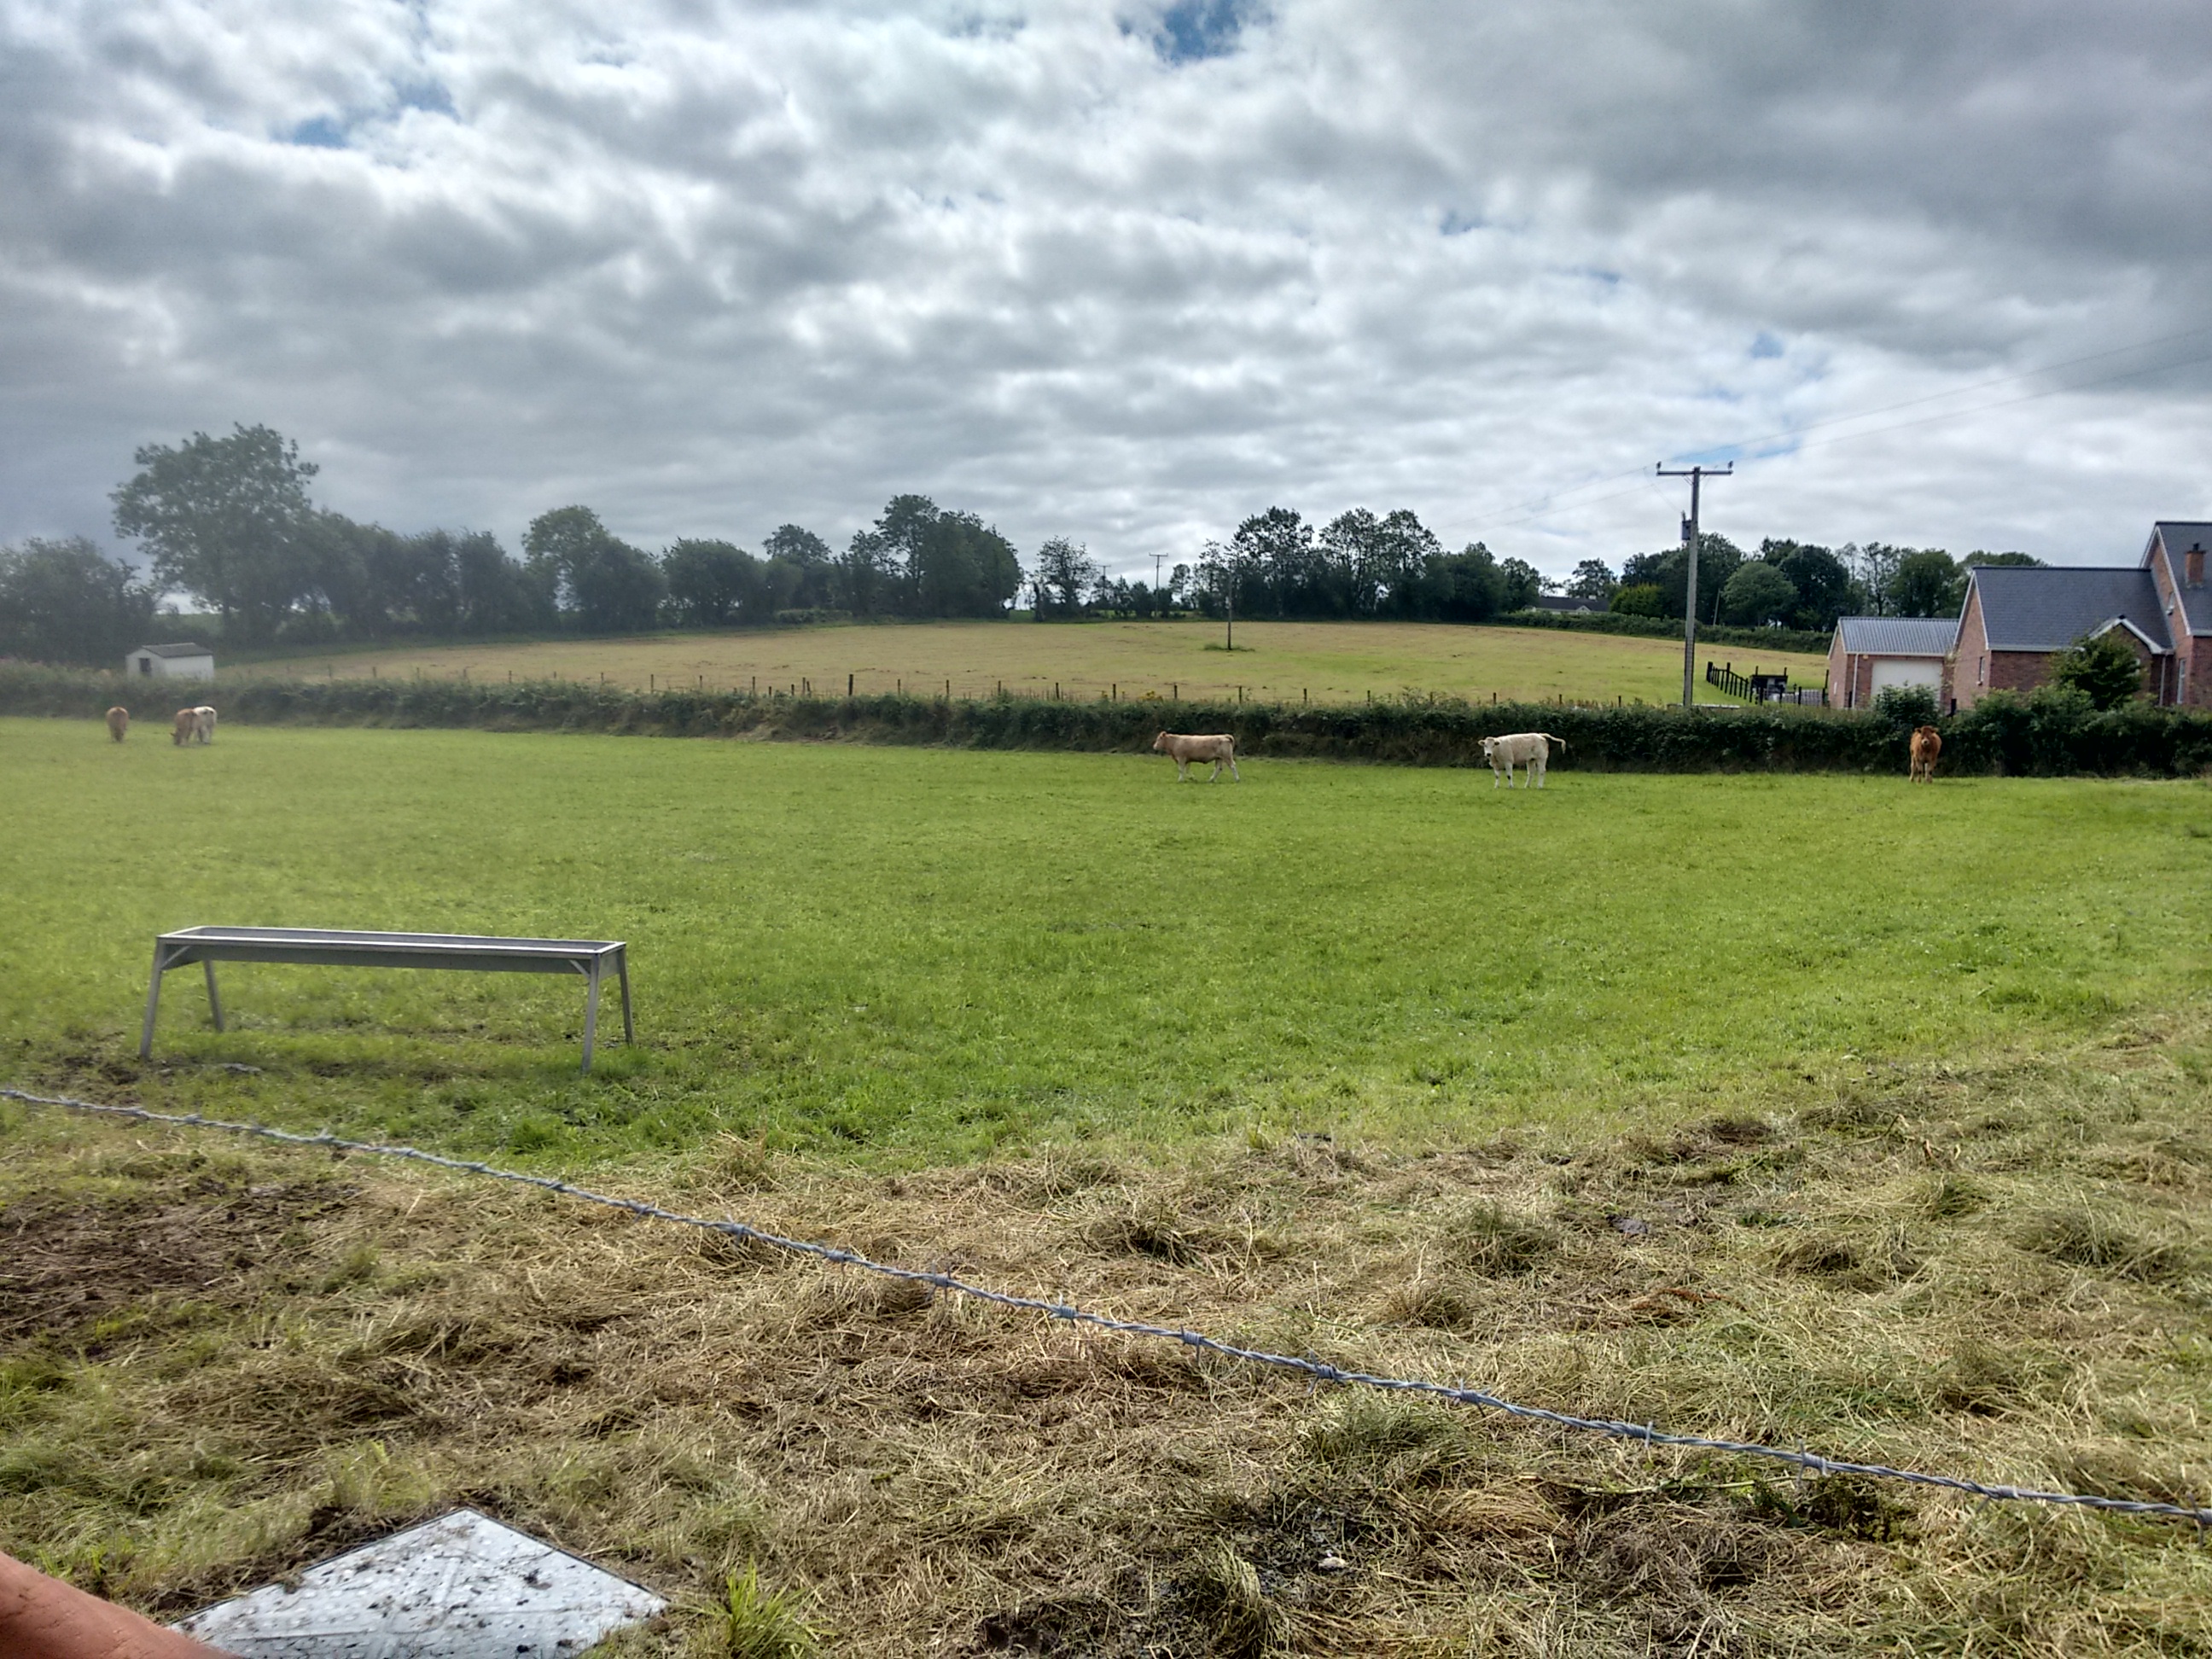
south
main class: Grassland
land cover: Grassland without tree/shrub cover
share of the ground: > 75 %
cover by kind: herbaceous plants 100 %
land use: Agriculture (excluding fallow land and kitchen gardens)
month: August
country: GB
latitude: 54.4499
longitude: -6.7418
